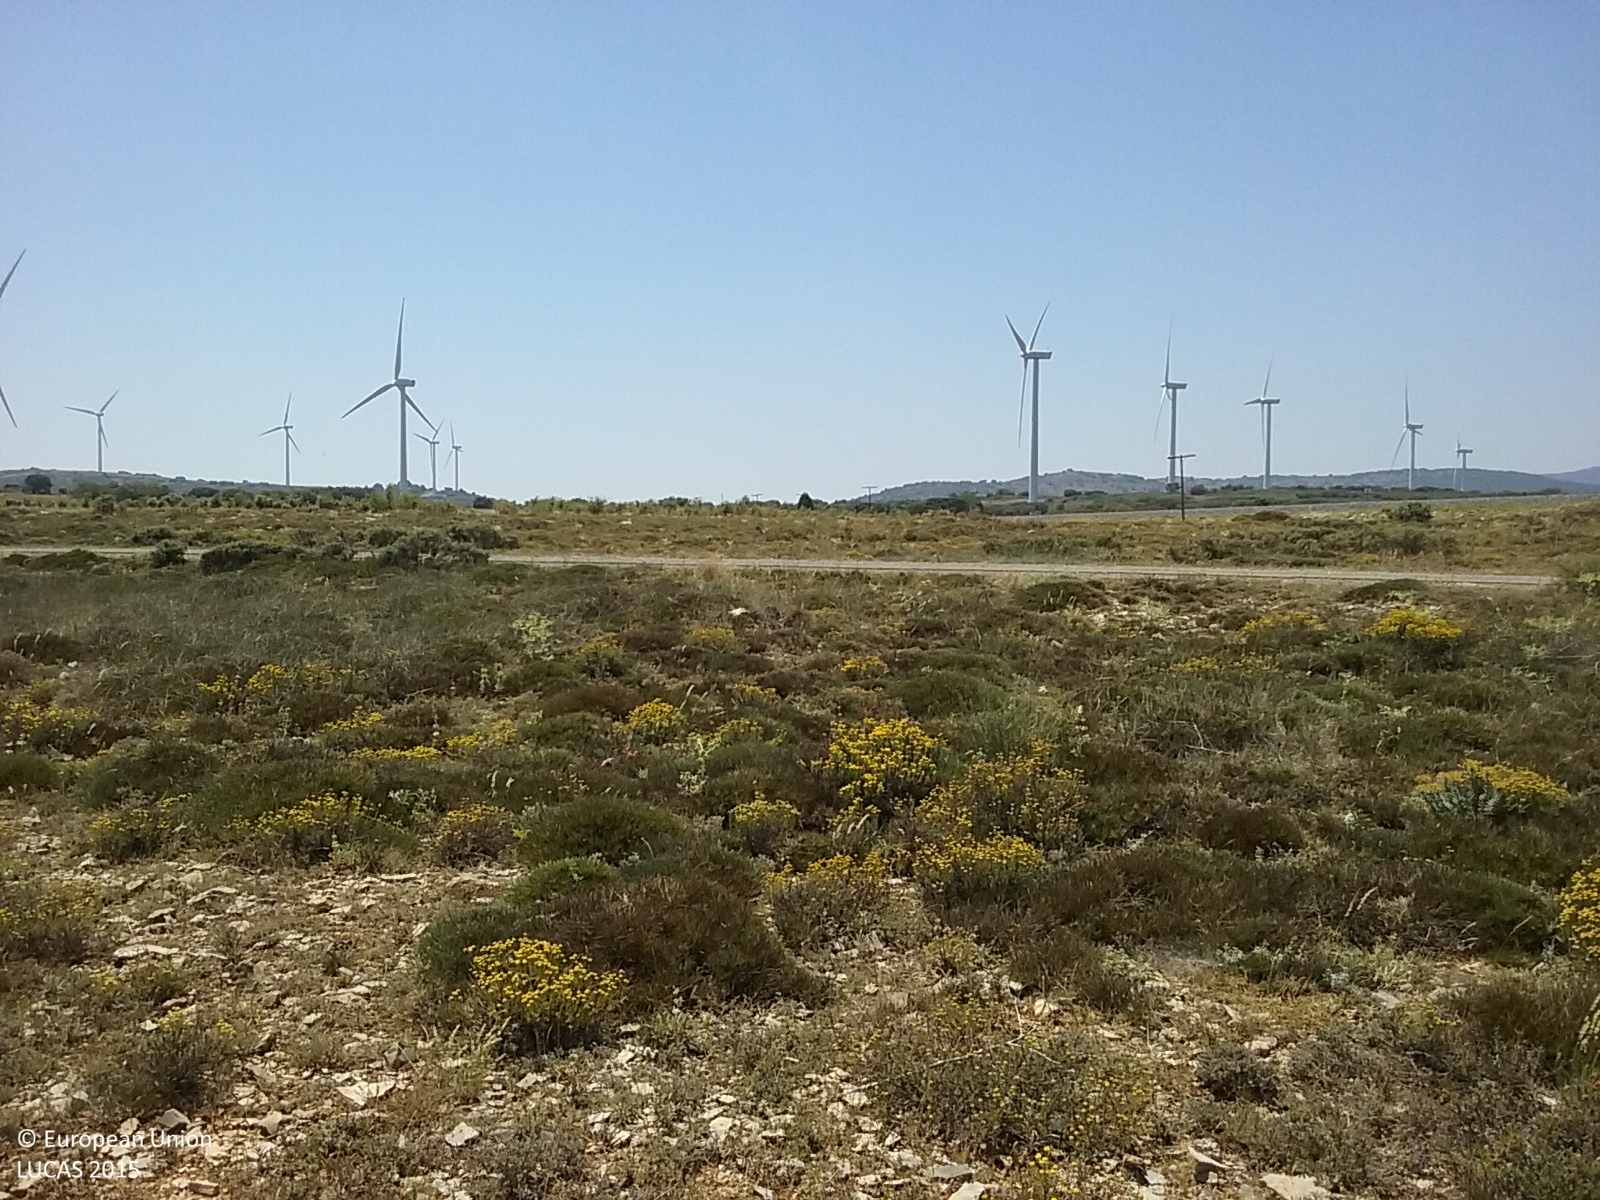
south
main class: Grassland
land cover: Spontaneously vegetated surfaces
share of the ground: 50 - 75 %
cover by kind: herbaceous plants 75 %, unconsolidated bare surface 20 %, shrubs 5 %
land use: Semi-natural and natural areas not in use
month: July
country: ES
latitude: 39.9729
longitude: -0.6941
